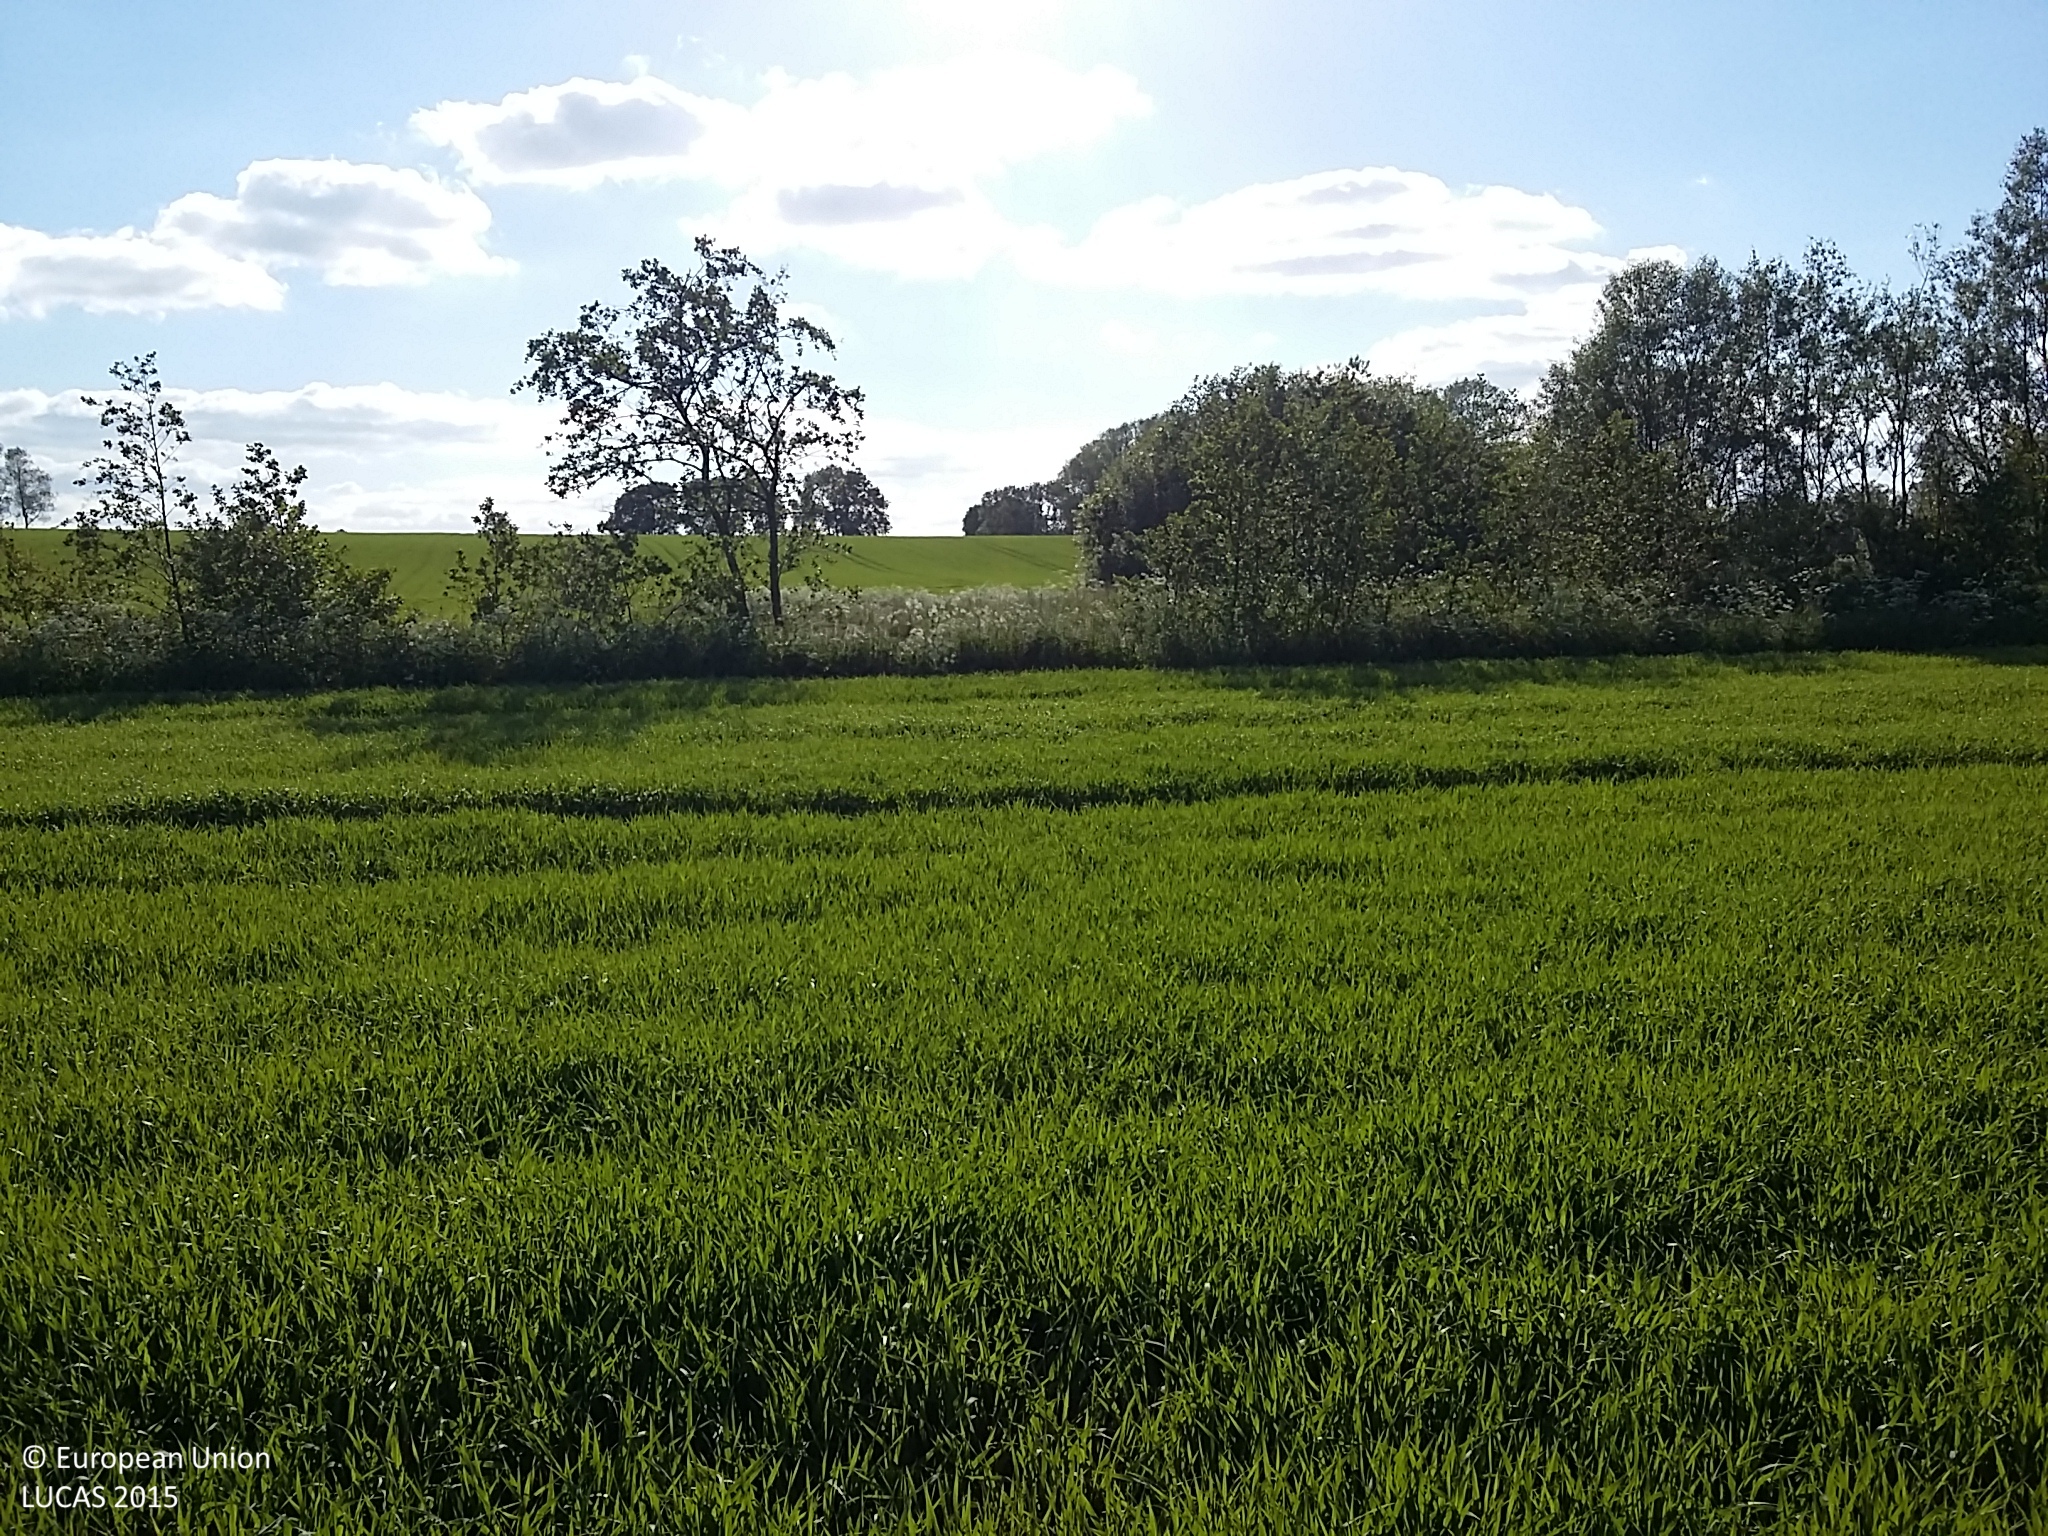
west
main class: Cropland
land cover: Barley
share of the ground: > 75 %
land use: Agriculture (excluding fallow land and kitchen gardens)
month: June
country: DK
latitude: 55.2153
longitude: 10.6753
